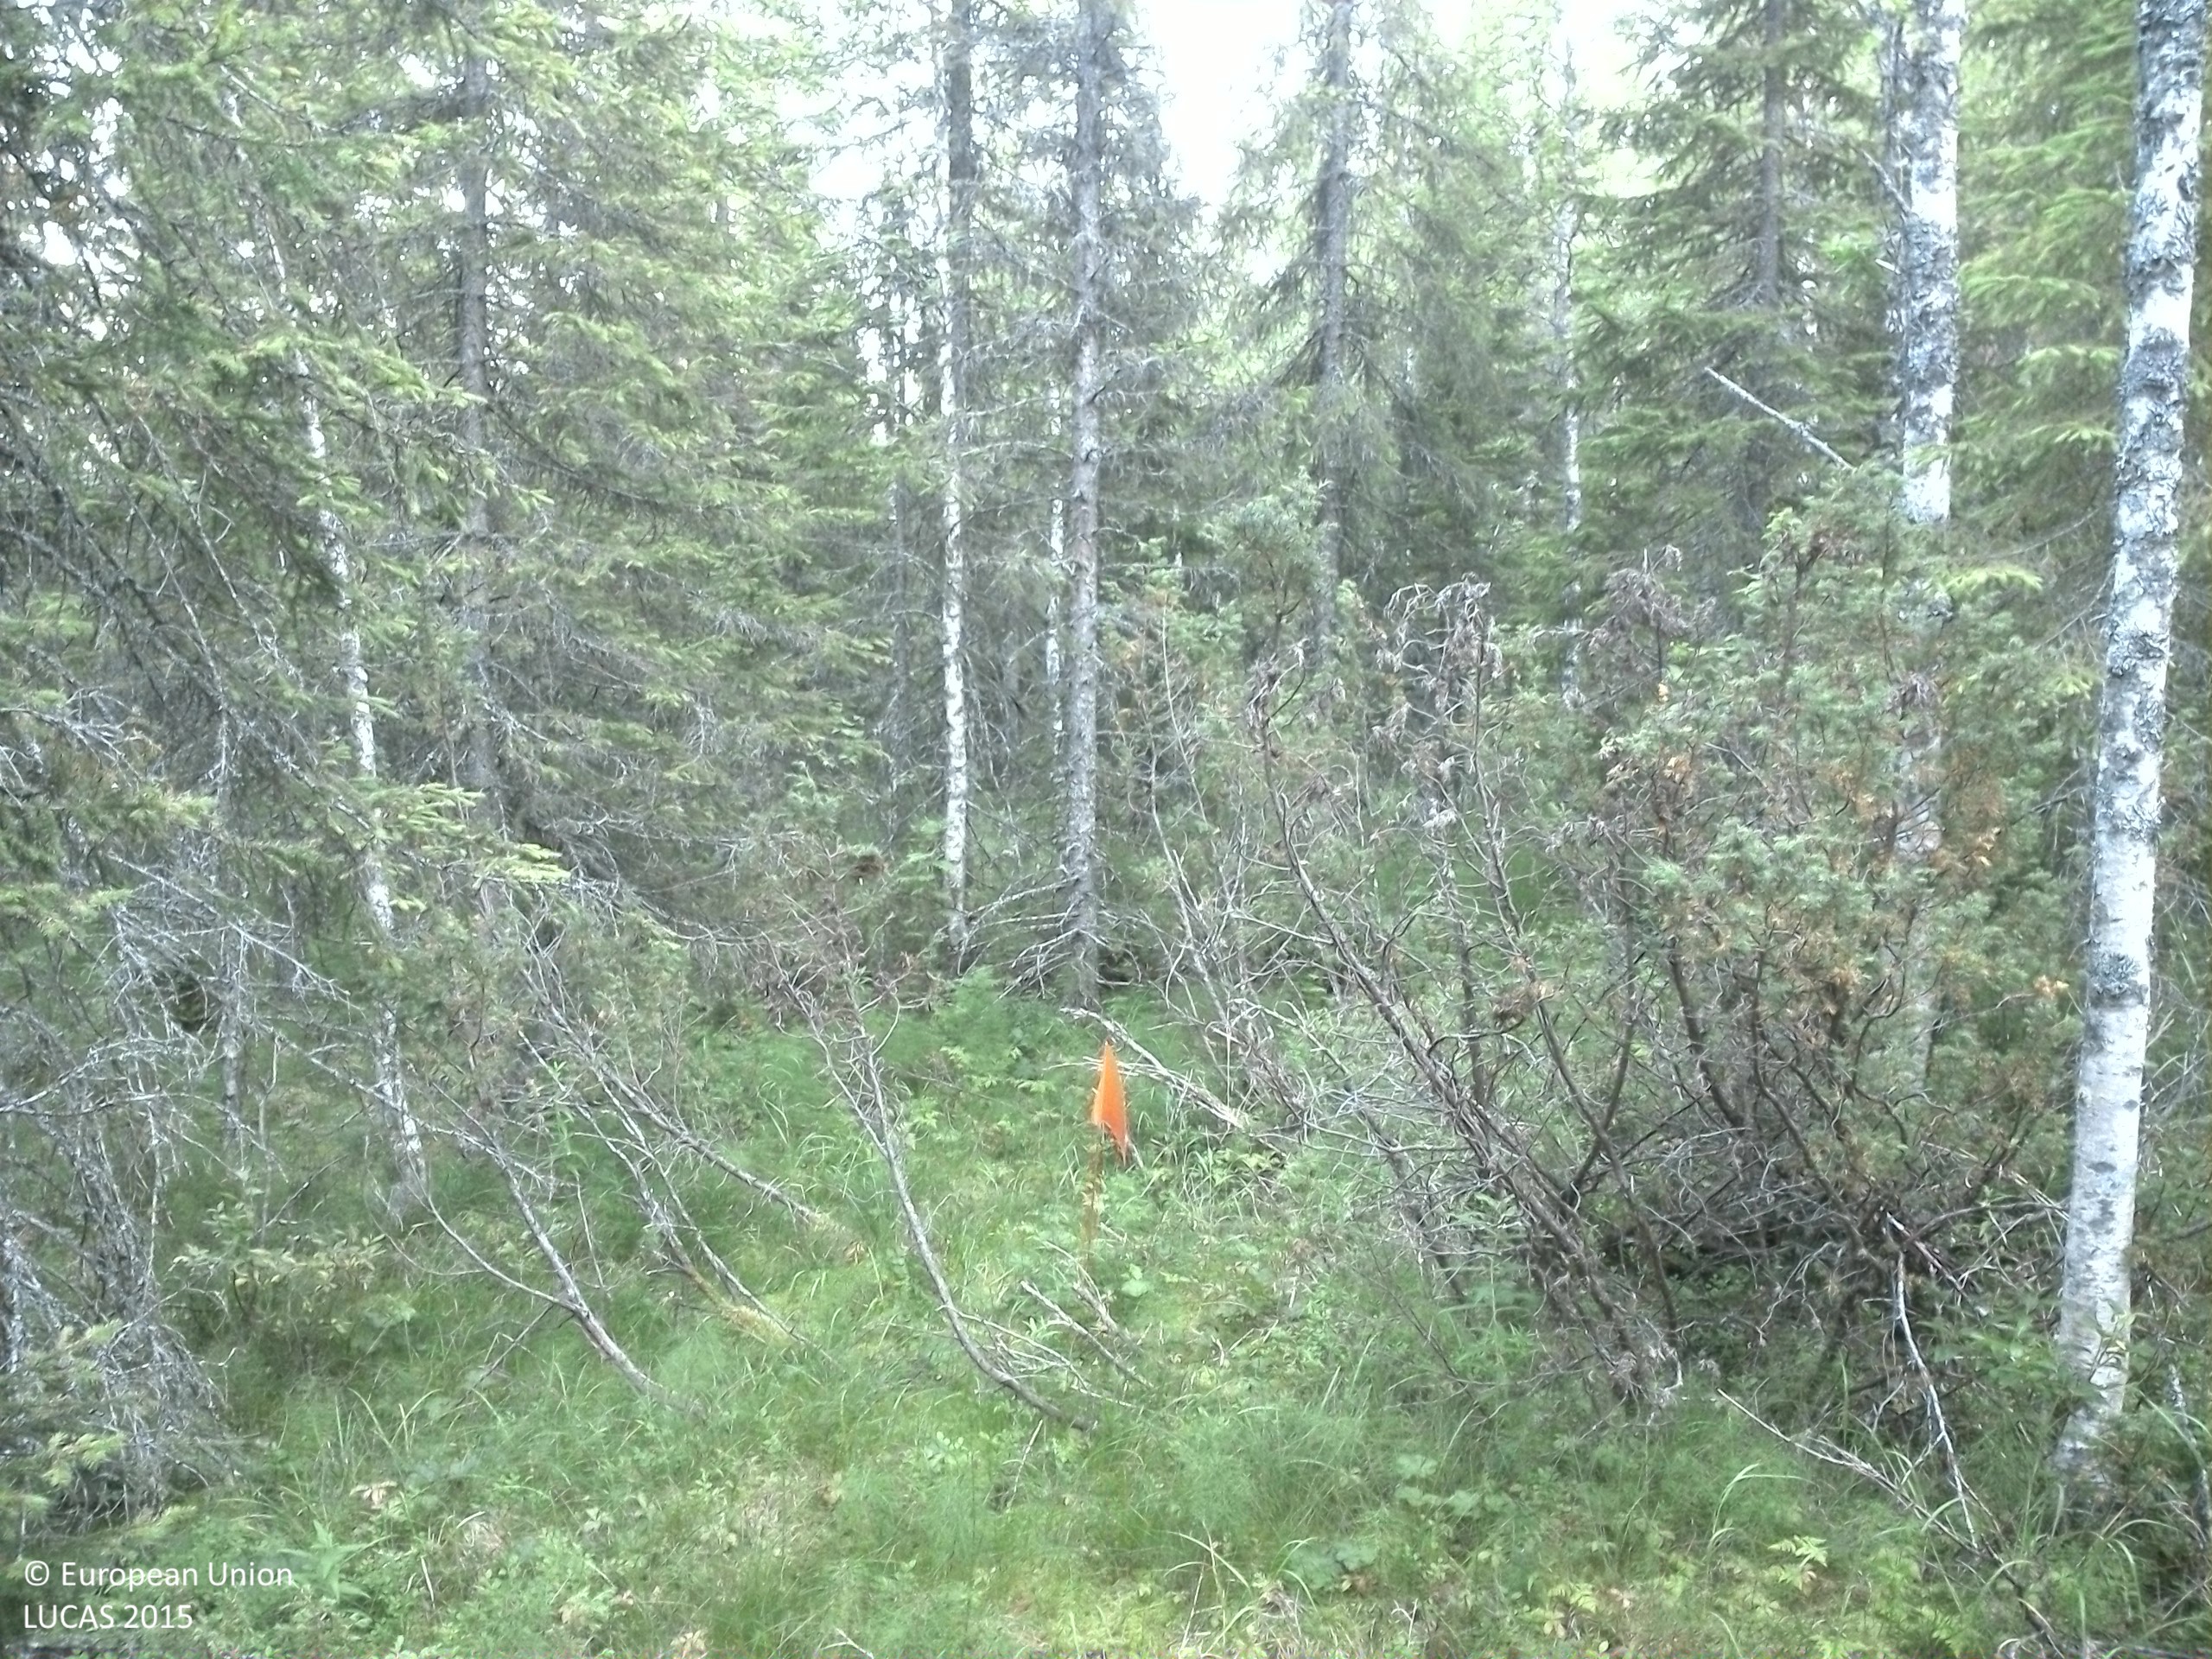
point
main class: Woodland
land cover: Spruce dominated mixed woodland
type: boreal forest
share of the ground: > 75 %
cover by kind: coniferous forest trees 45 %, shrubs 25 %, broadleaved forest trees 20 %, herbaceous plants 10 %
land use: Forestry
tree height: > 5 m
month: August
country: SE
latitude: 63.8212
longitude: 17.8753
